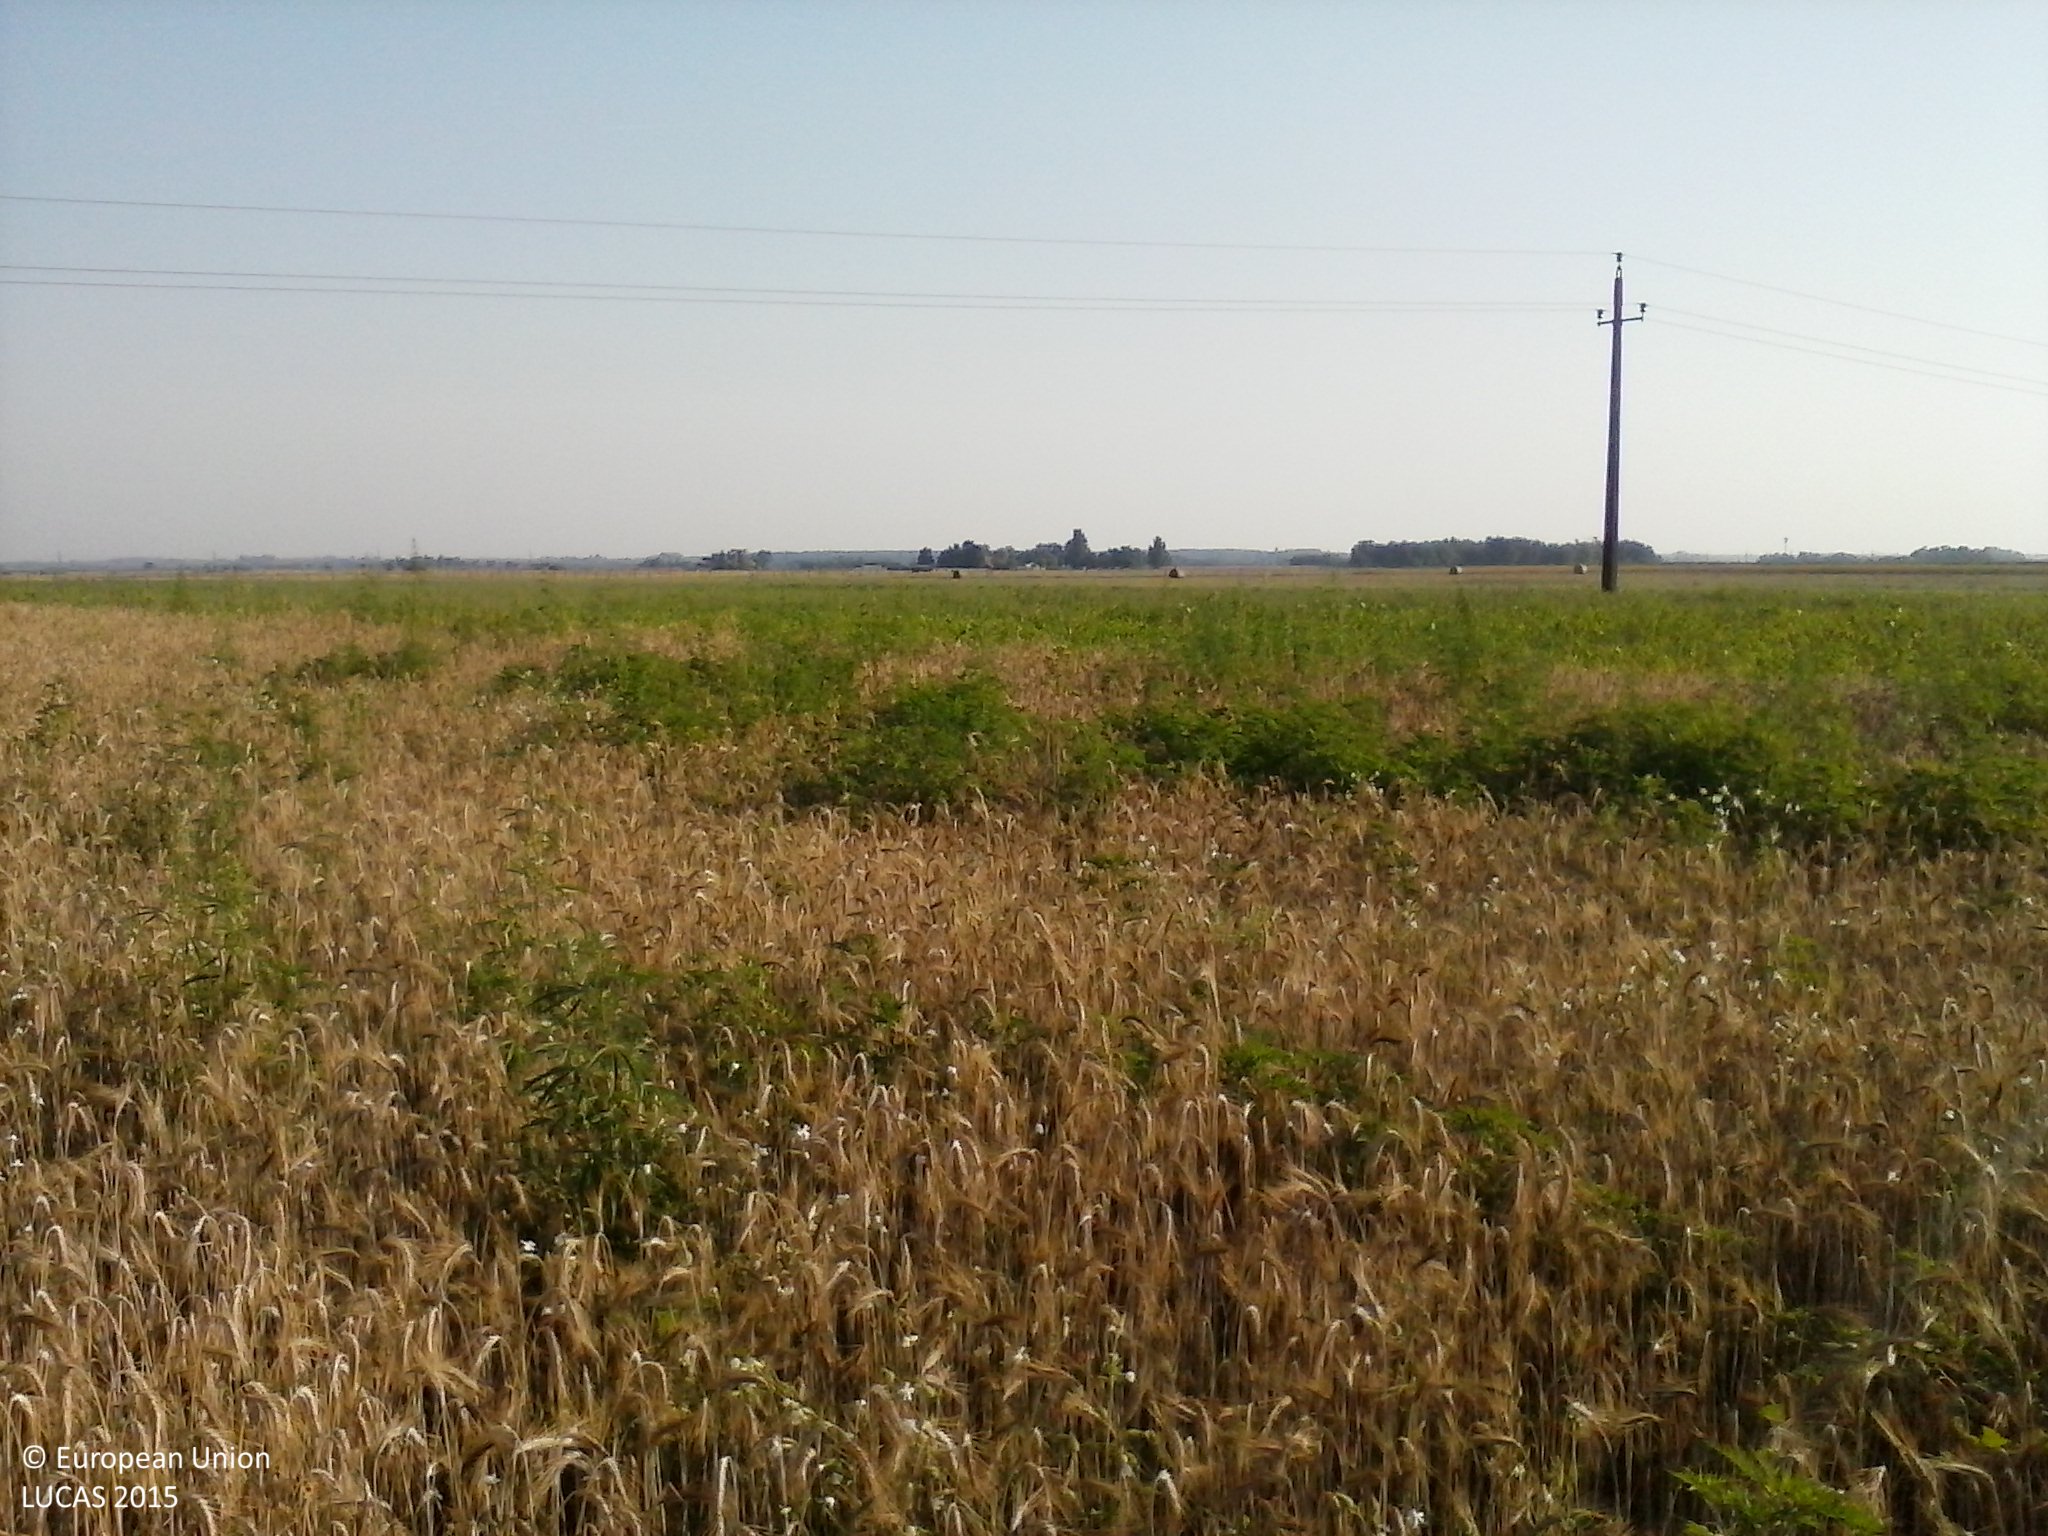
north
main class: Cropland
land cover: Common wheat
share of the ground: > 75 %
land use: Agriculture (excluding fallow land and kitchen gardens)
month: July
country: HU
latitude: 46.4456
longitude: 19.5856
